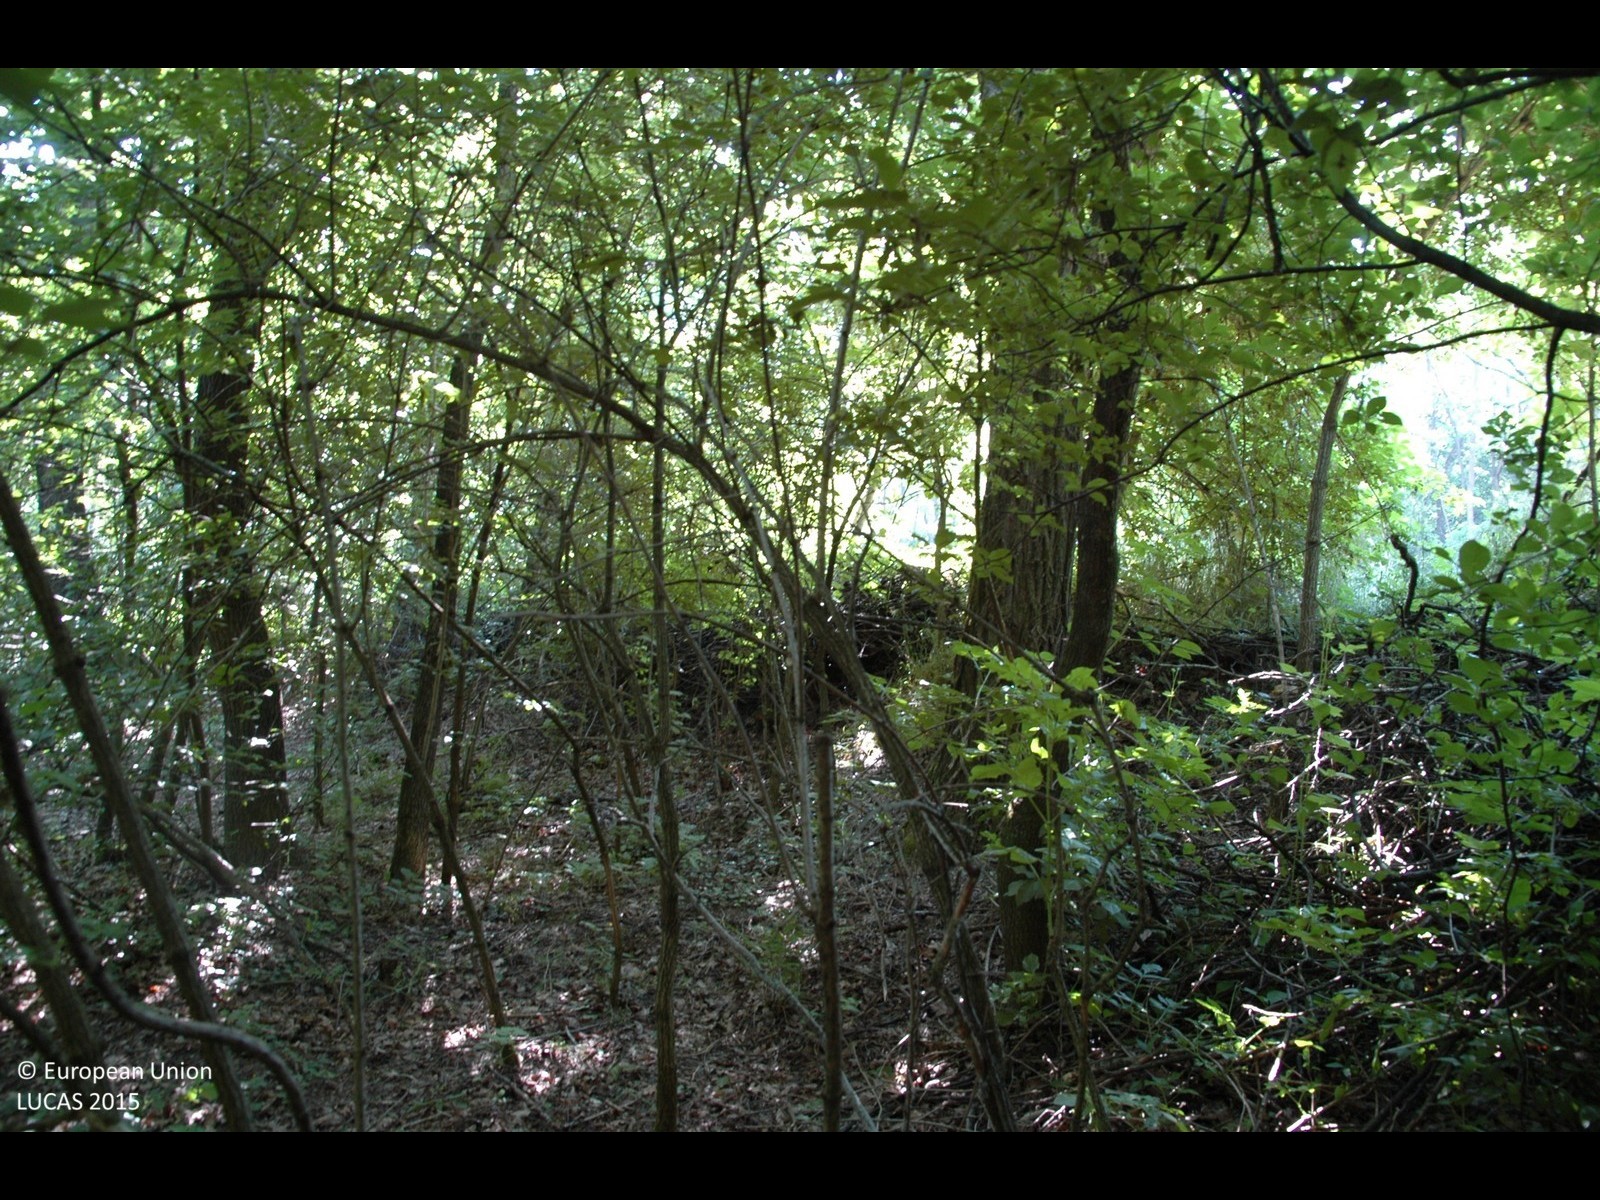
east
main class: Woodland
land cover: Broadleaved woodland
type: mesophytic deciduous forest
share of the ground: > 75 %
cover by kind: broadleaved forest trees 90 %, shrubs 5 %, herbaceous plants 5 %
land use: Forestry
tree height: > 5 m
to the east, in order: Broadleaved woodland; Tracks; Ditches and canals; Tracks; Broadleaved woodland; Rape and turnip rape
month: May
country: HR
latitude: 46.4997
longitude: 16.4509
